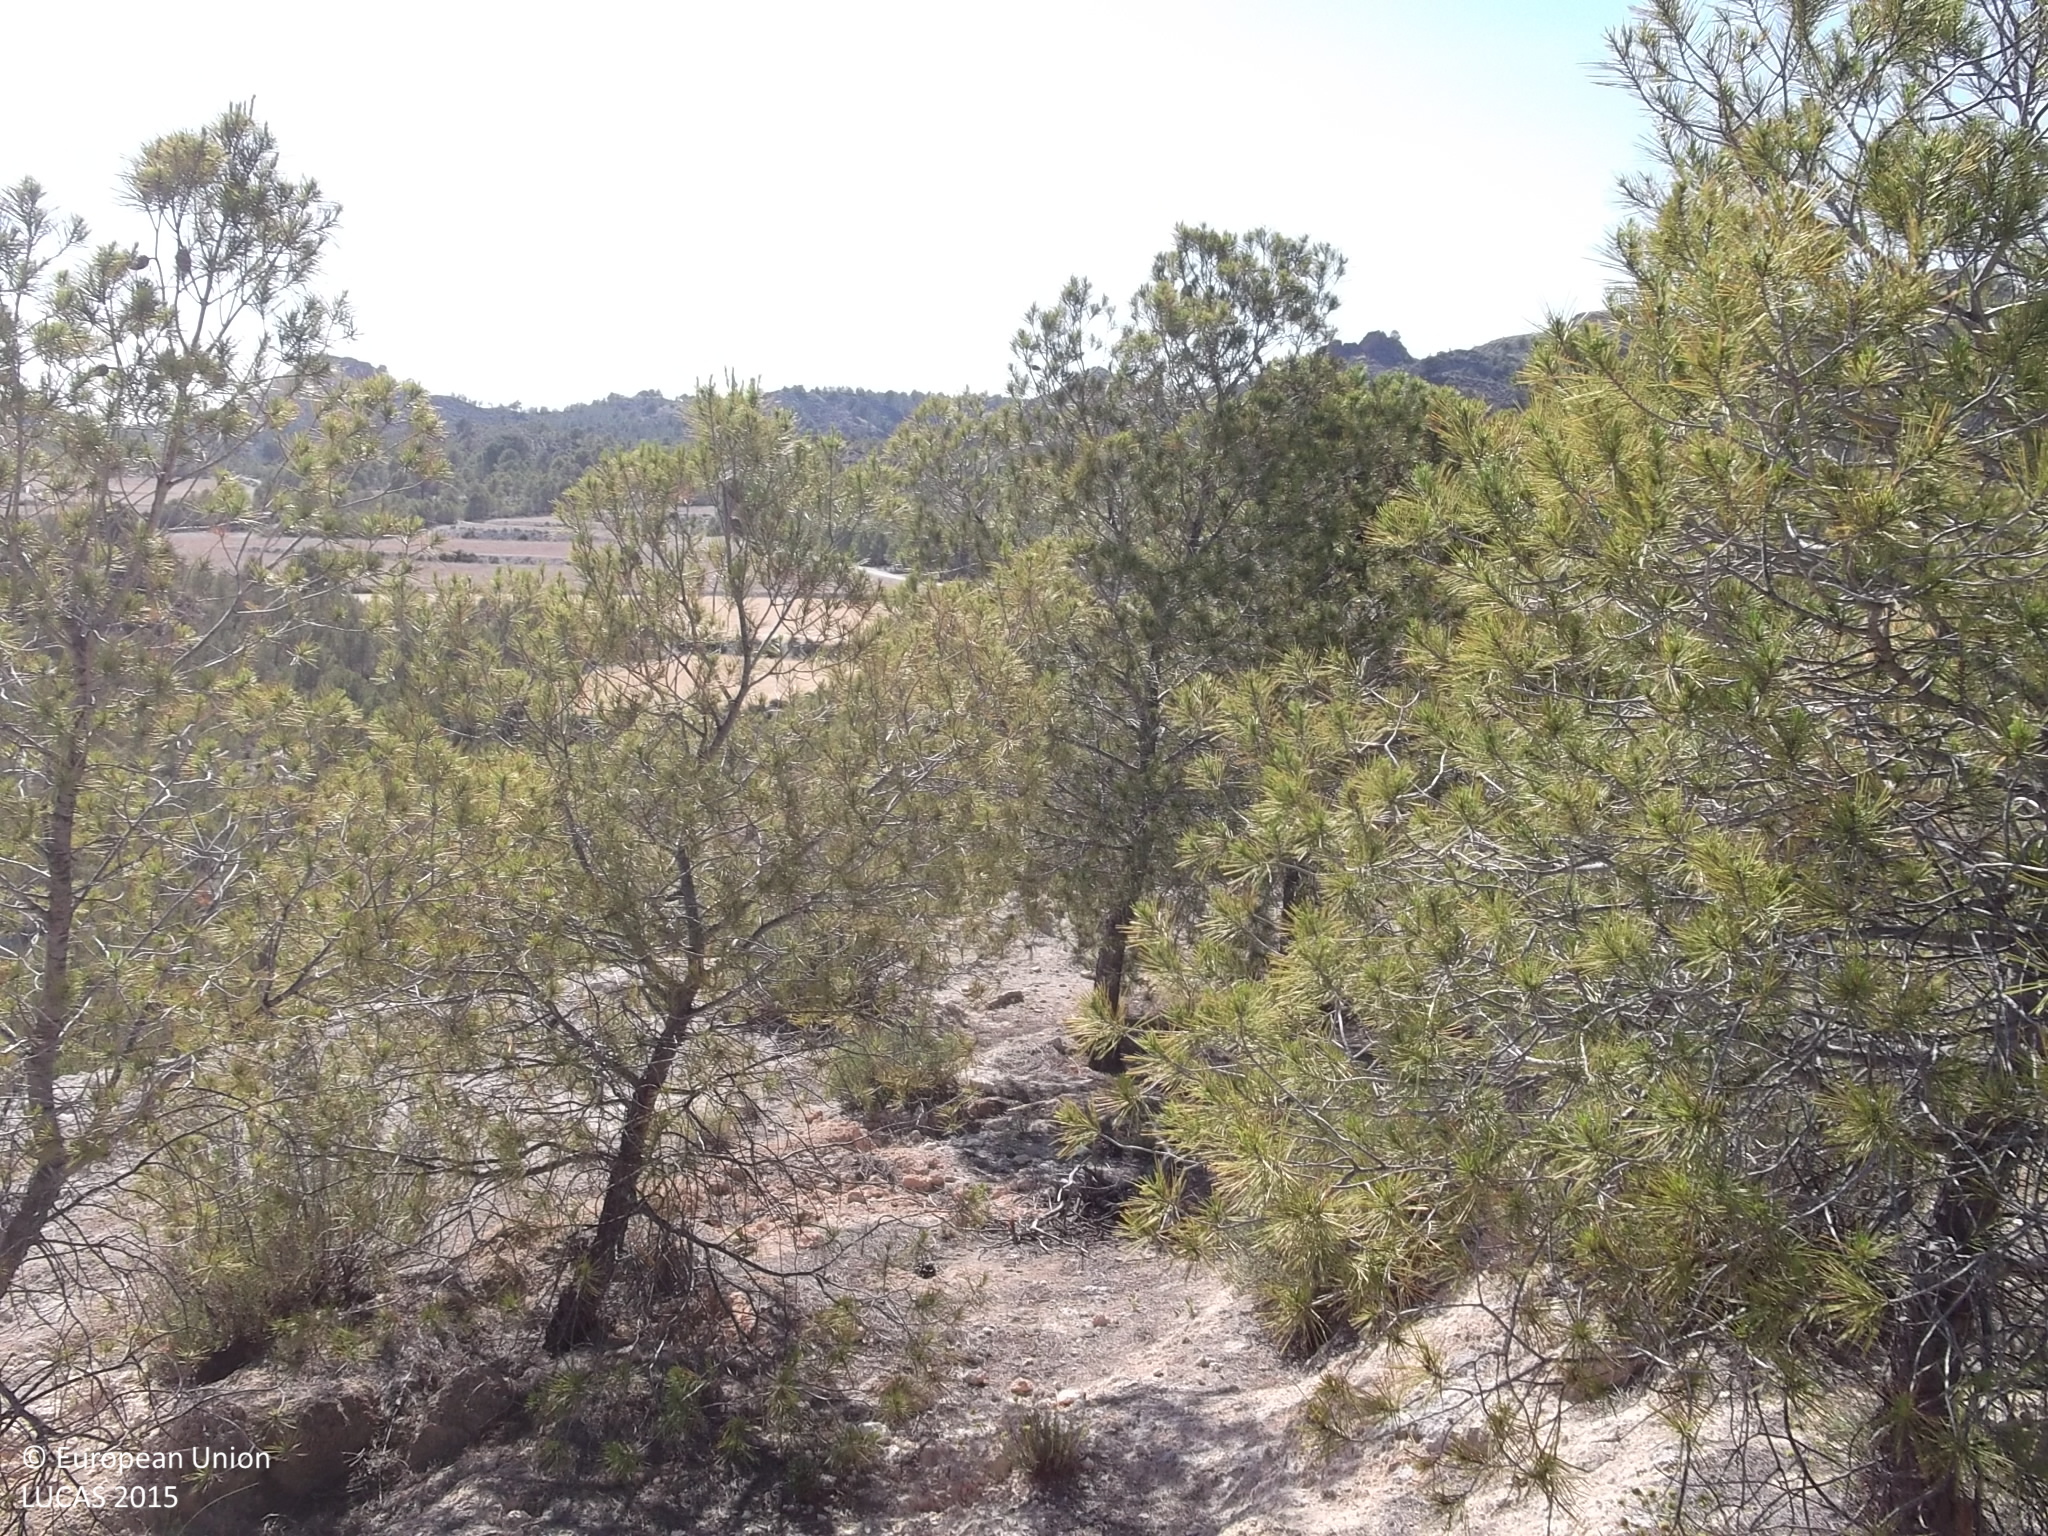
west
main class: Woodland
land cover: Pine dominated coniferous woodland
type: coniferous forest of the mediterranean region
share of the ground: 25 - 50 %
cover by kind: herbaceous plants 30 %, coniferous forest trees 25 %, shrubs 25 %, consolidated bare surface 20 %
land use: Semi-natural and natural areas not in use
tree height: > 5 m
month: June
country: ES
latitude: 38.2030
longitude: -1.6256
